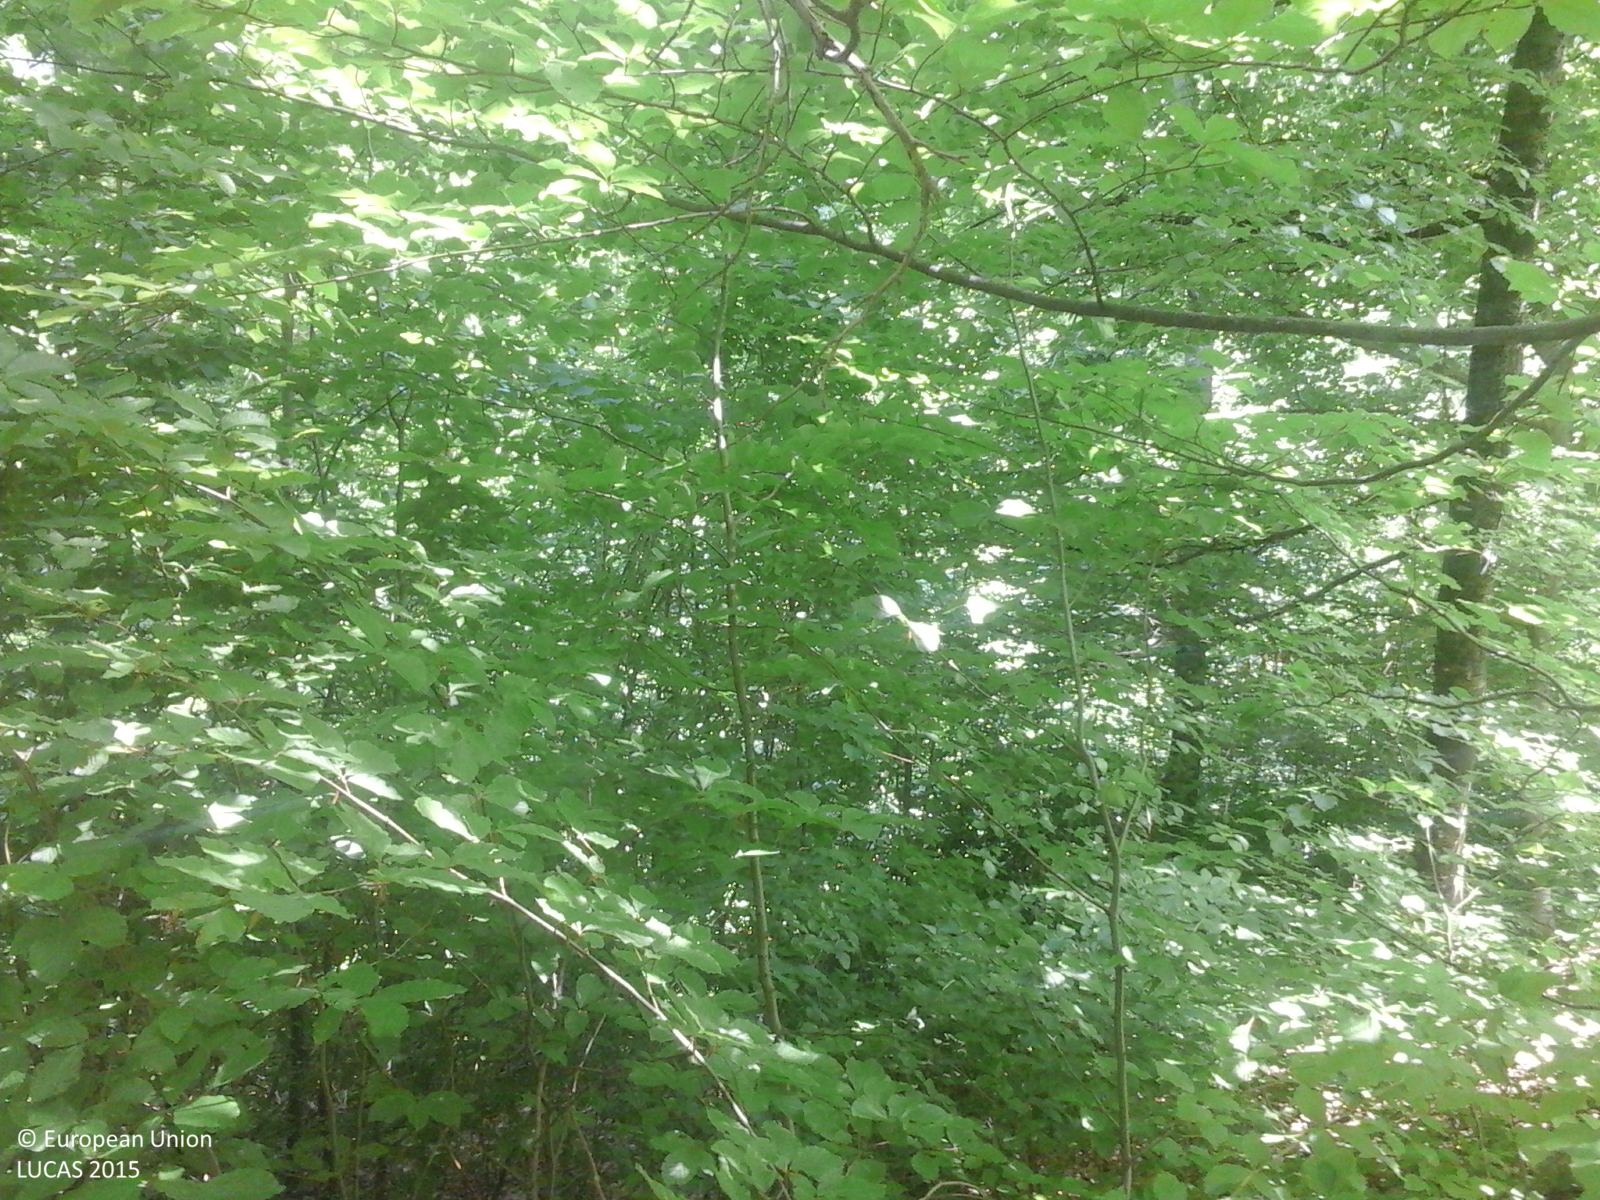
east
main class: Woodland
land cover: Broadleaved woodland
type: beech forest
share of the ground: > 75 %
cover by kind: broadleaved forest trees 100 %
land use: Forestry
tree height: > 5 m
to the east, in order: Broadleaved woodland; Tracks; Broadleaved woodland; Tracks; Broadleaved woodland
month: July
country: RO
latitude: 45.0365
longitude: 25.0791
